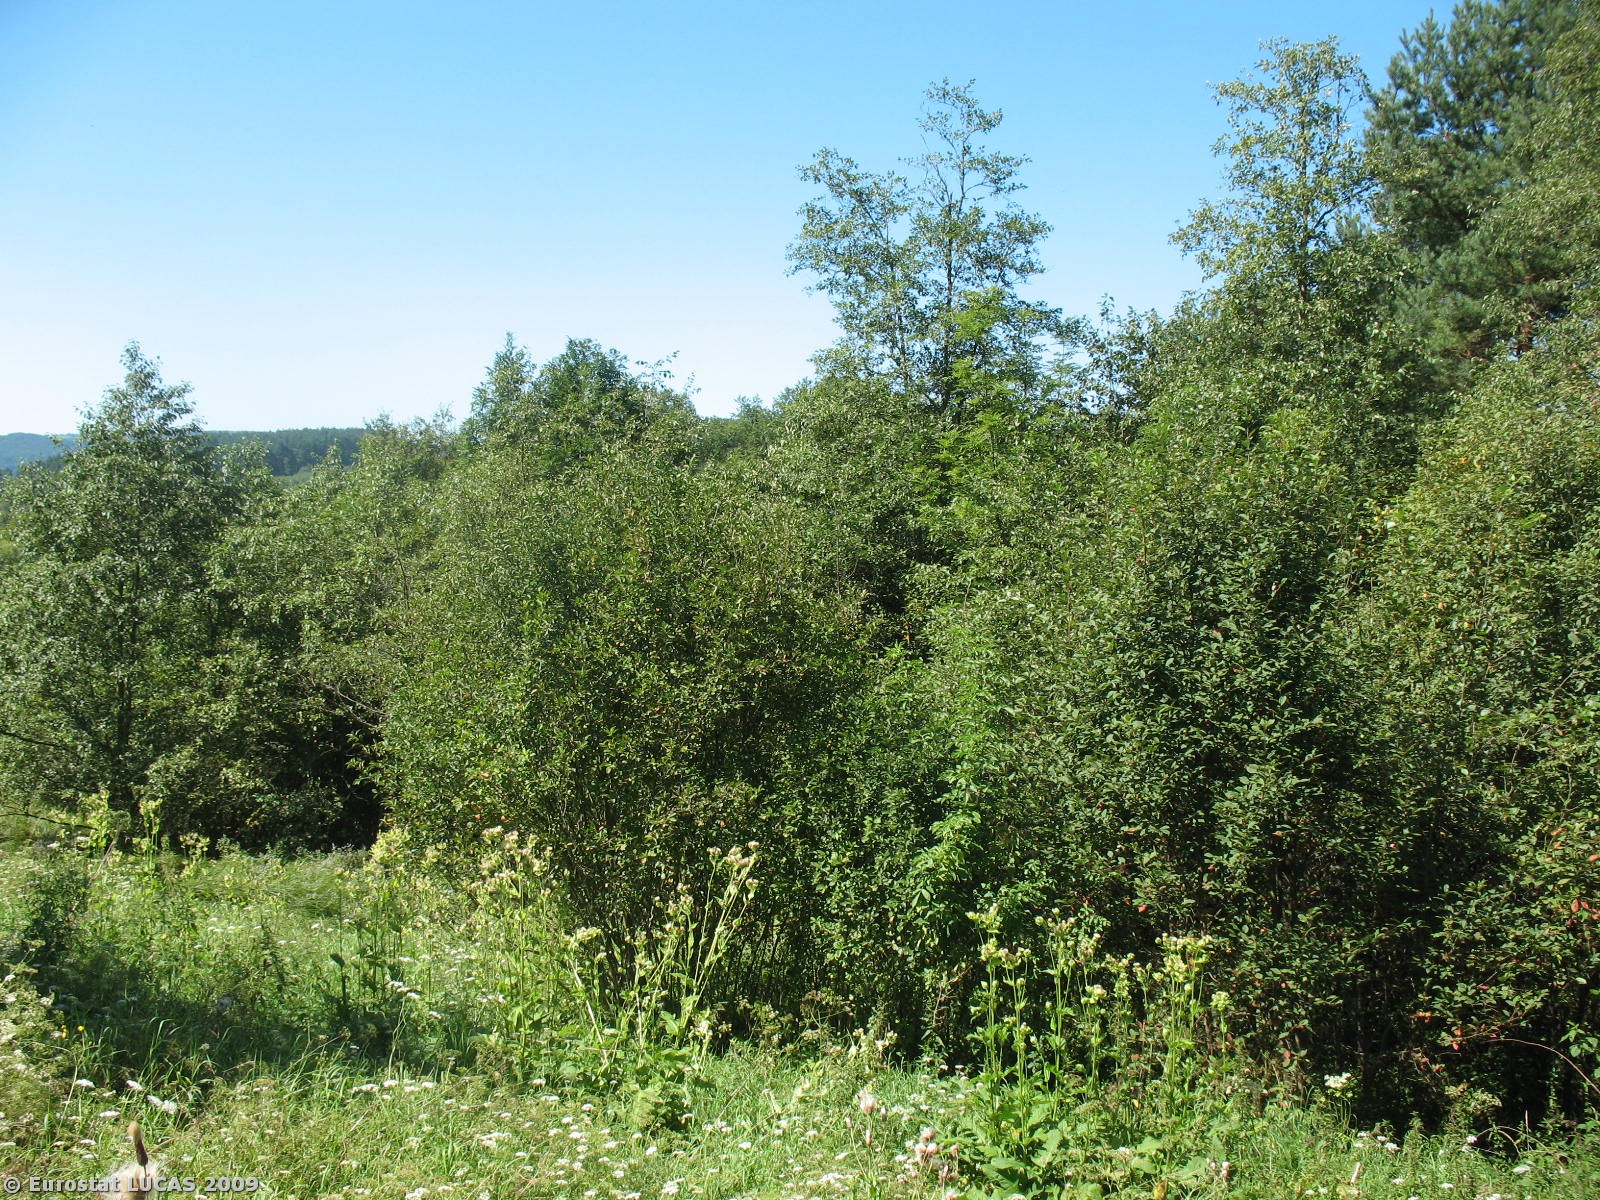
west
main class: Grassland
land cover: Spontaneously vegetated surfaces
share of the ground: > 75 %
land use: Unused
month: August
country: PL
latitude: 49.4697
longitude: 22.2171
